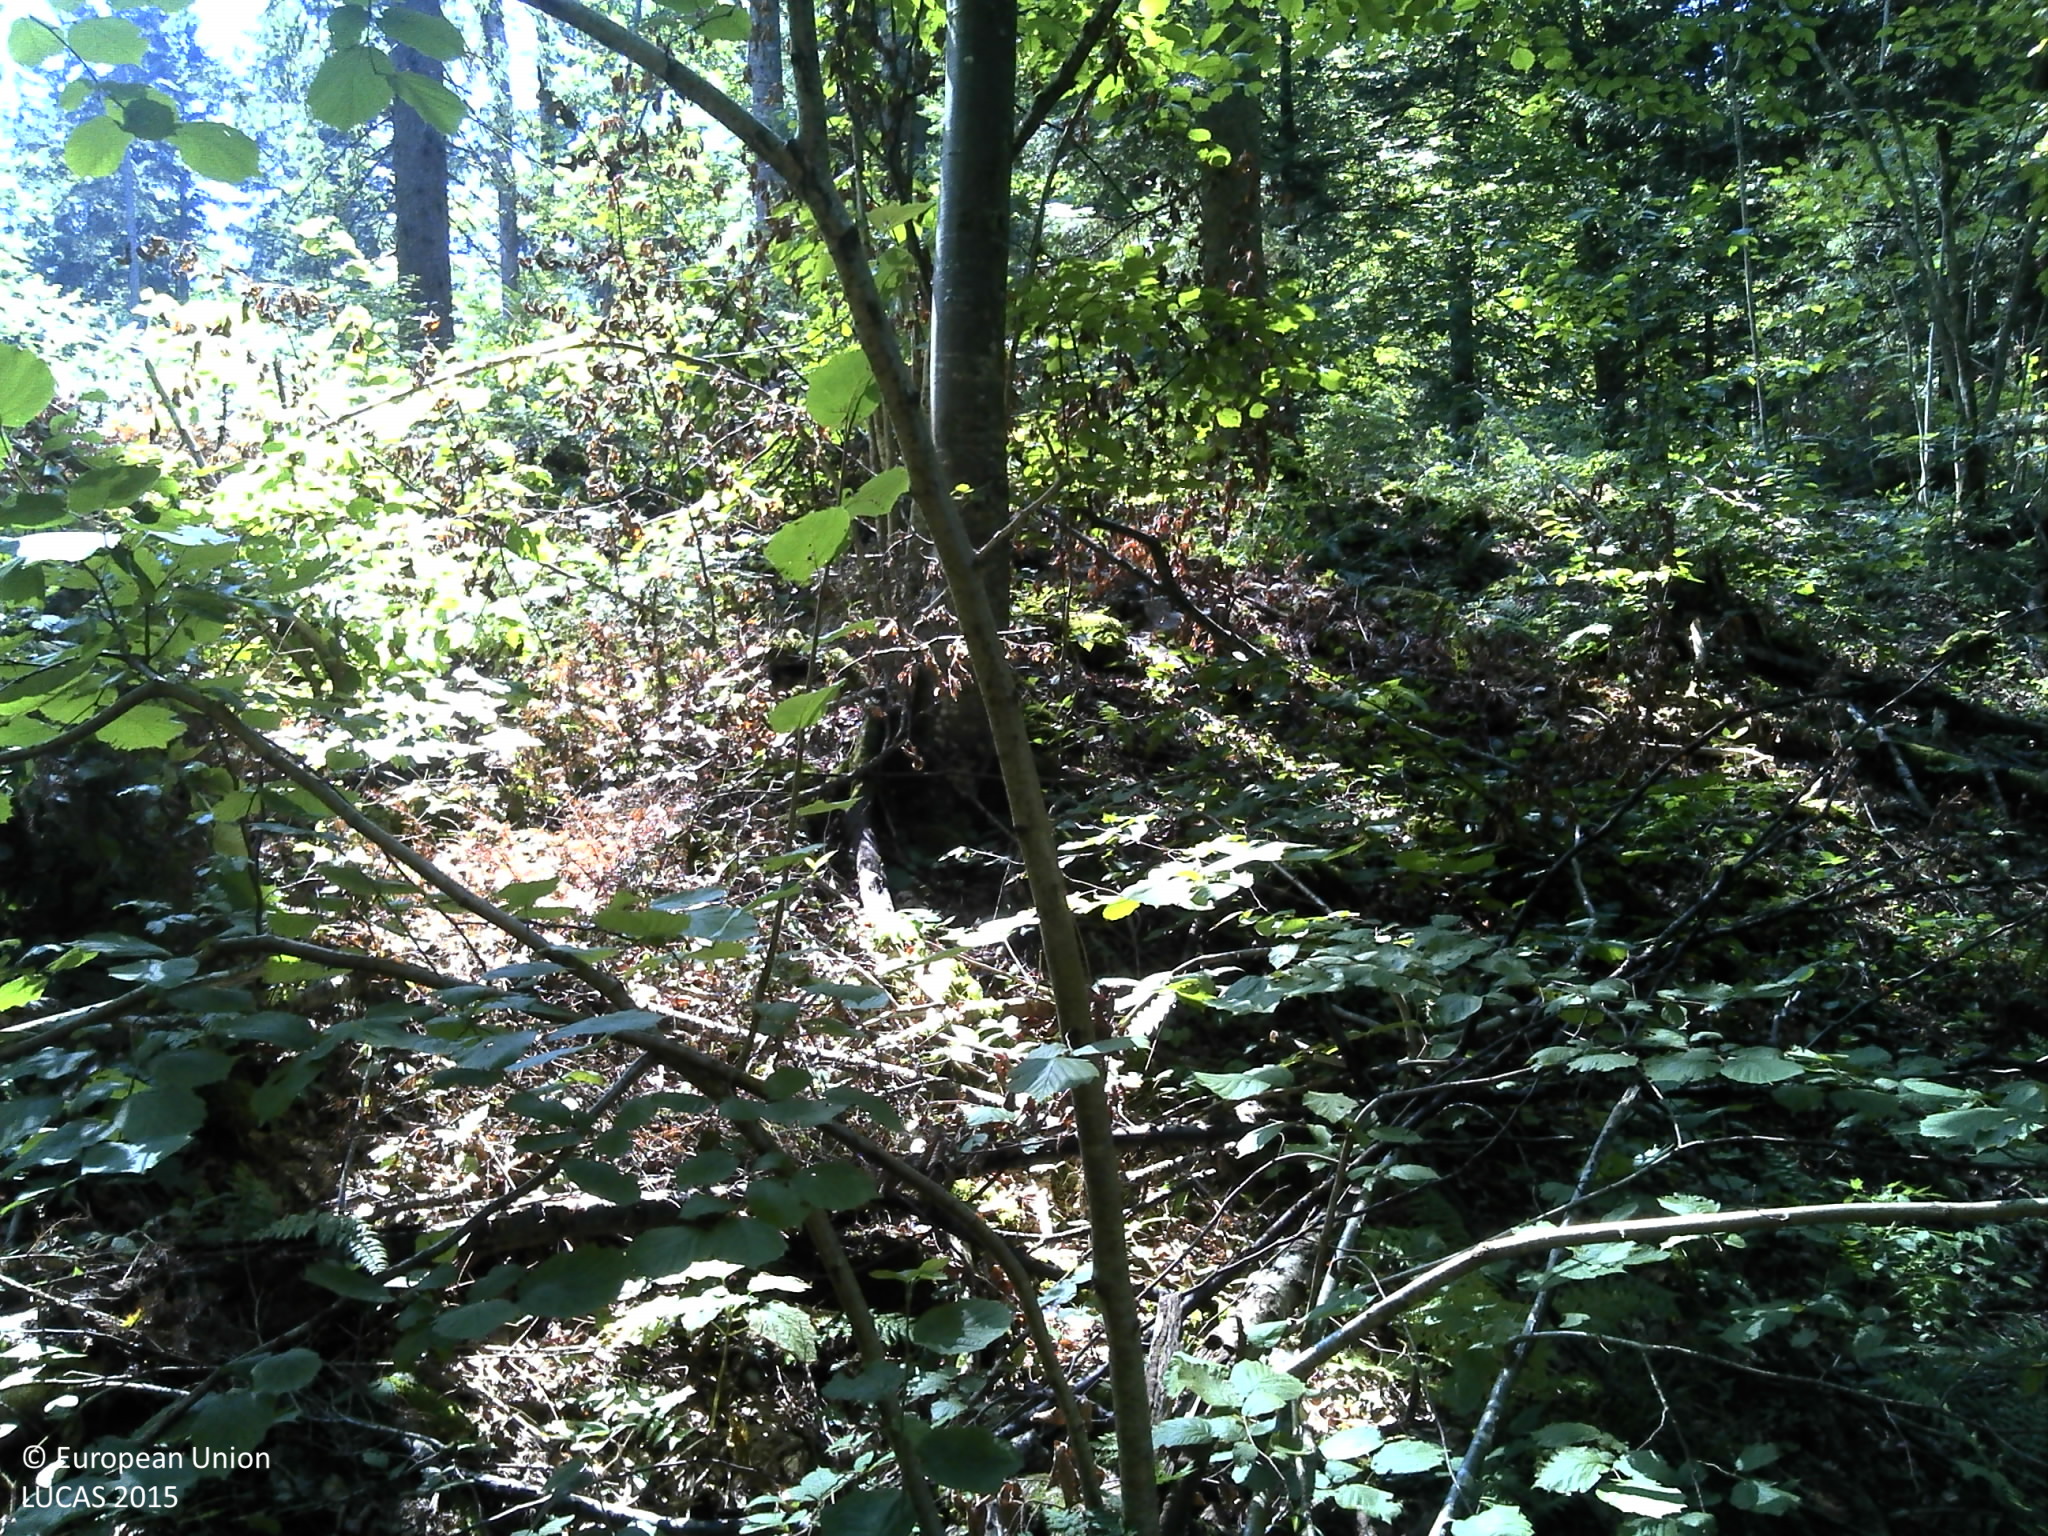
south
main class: Woodland
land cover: Broadleaved woodland
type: beech forest
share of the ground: > 75 %
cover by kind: broadleaved forest trees 100 %
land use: Forestry
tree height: > 5 m
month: August
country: HR
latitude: 45.1789
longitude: 15.1743
